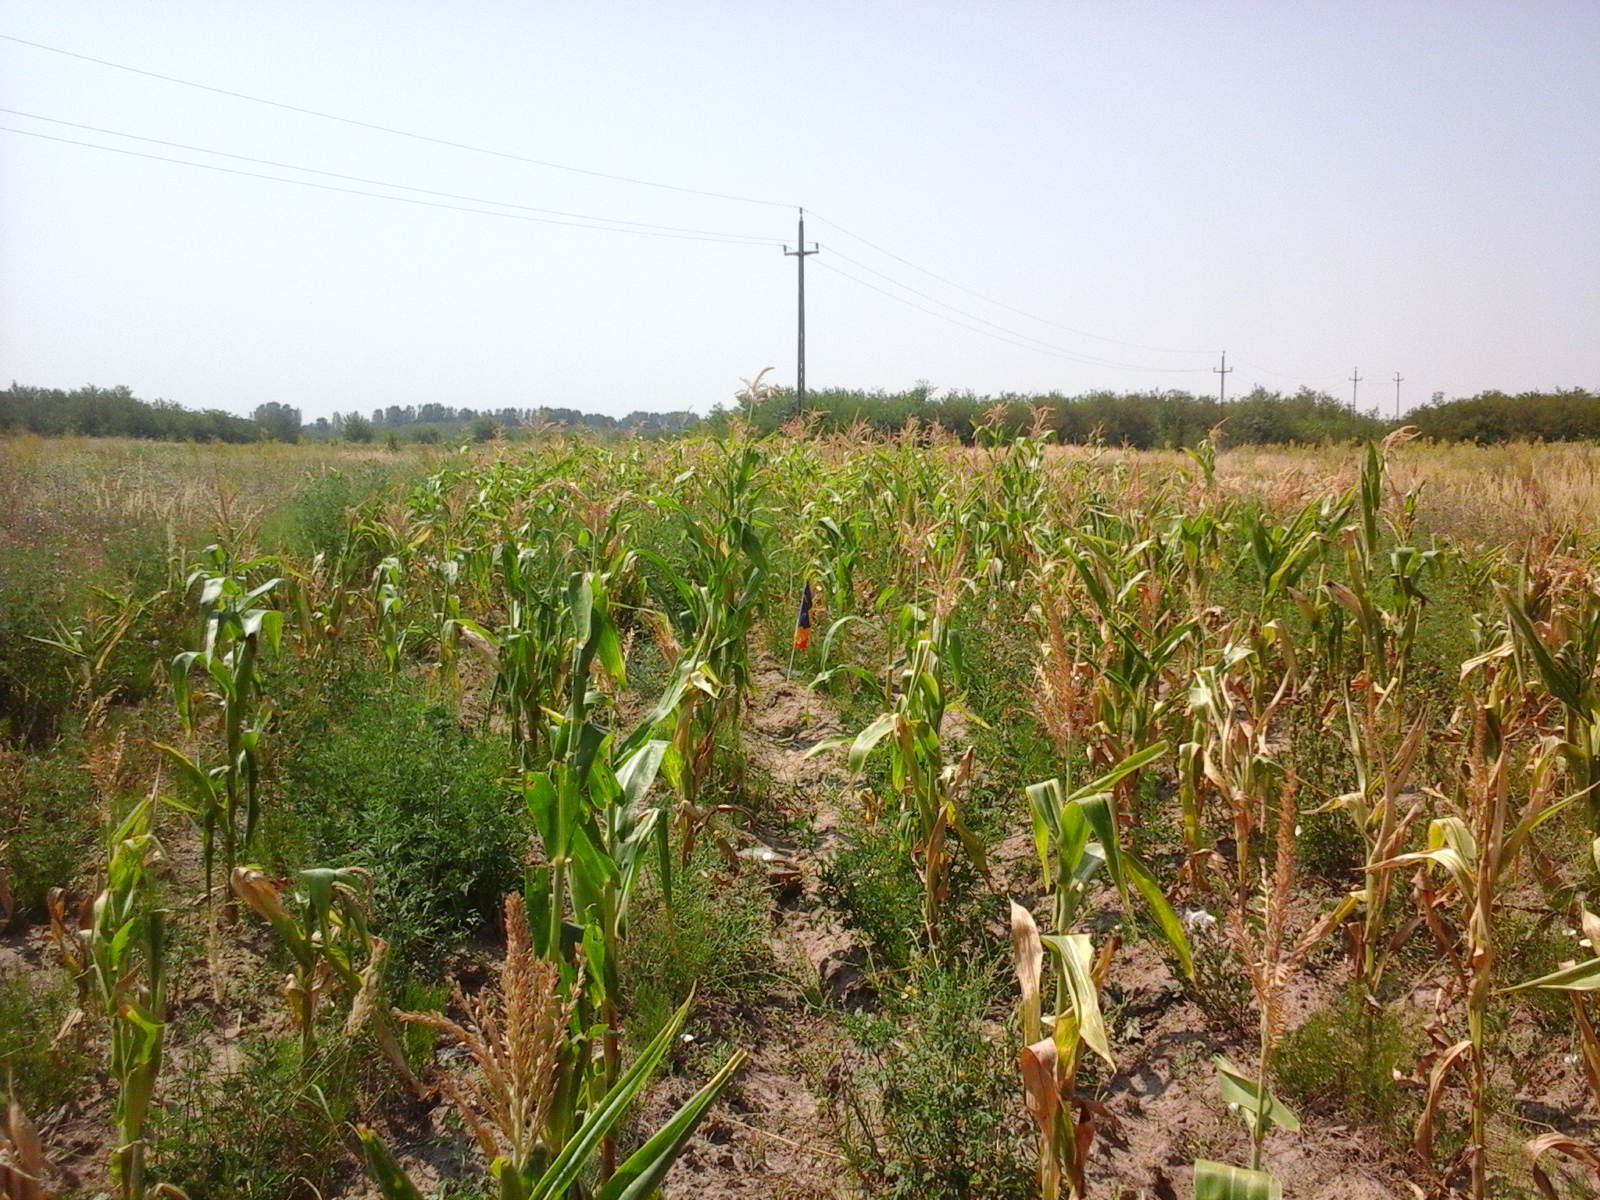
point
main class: Cropland
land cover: Maize
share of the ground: > 75 %
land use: Agriculture (excluding fallow land and kitchen gardens)
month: August
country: RO
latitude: 44.4075
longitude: 22.6852
